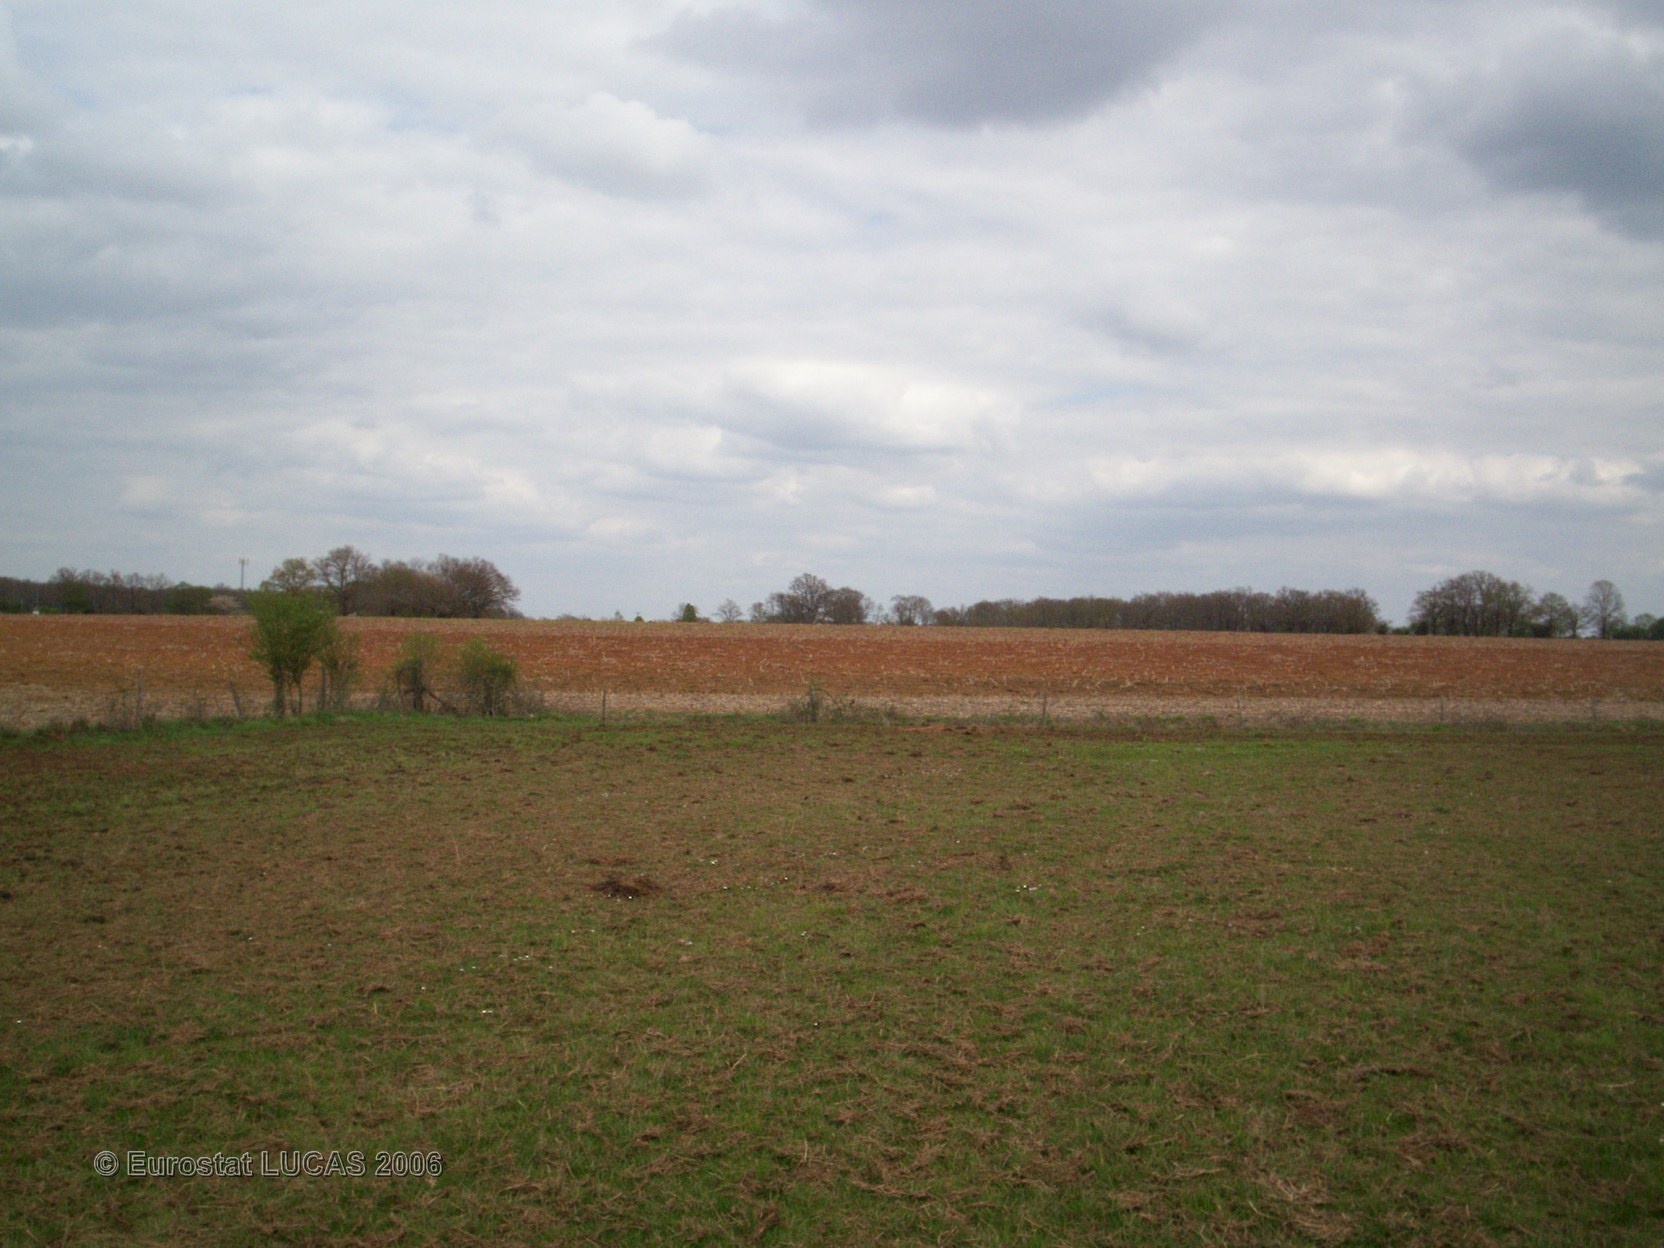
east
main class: Grassland
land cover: Grassland without tree/shrub cover
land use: Agriculture (excluding fallow land and kitchen gardens)
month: April
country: FR
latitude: 46.1135
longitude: 0.5522
